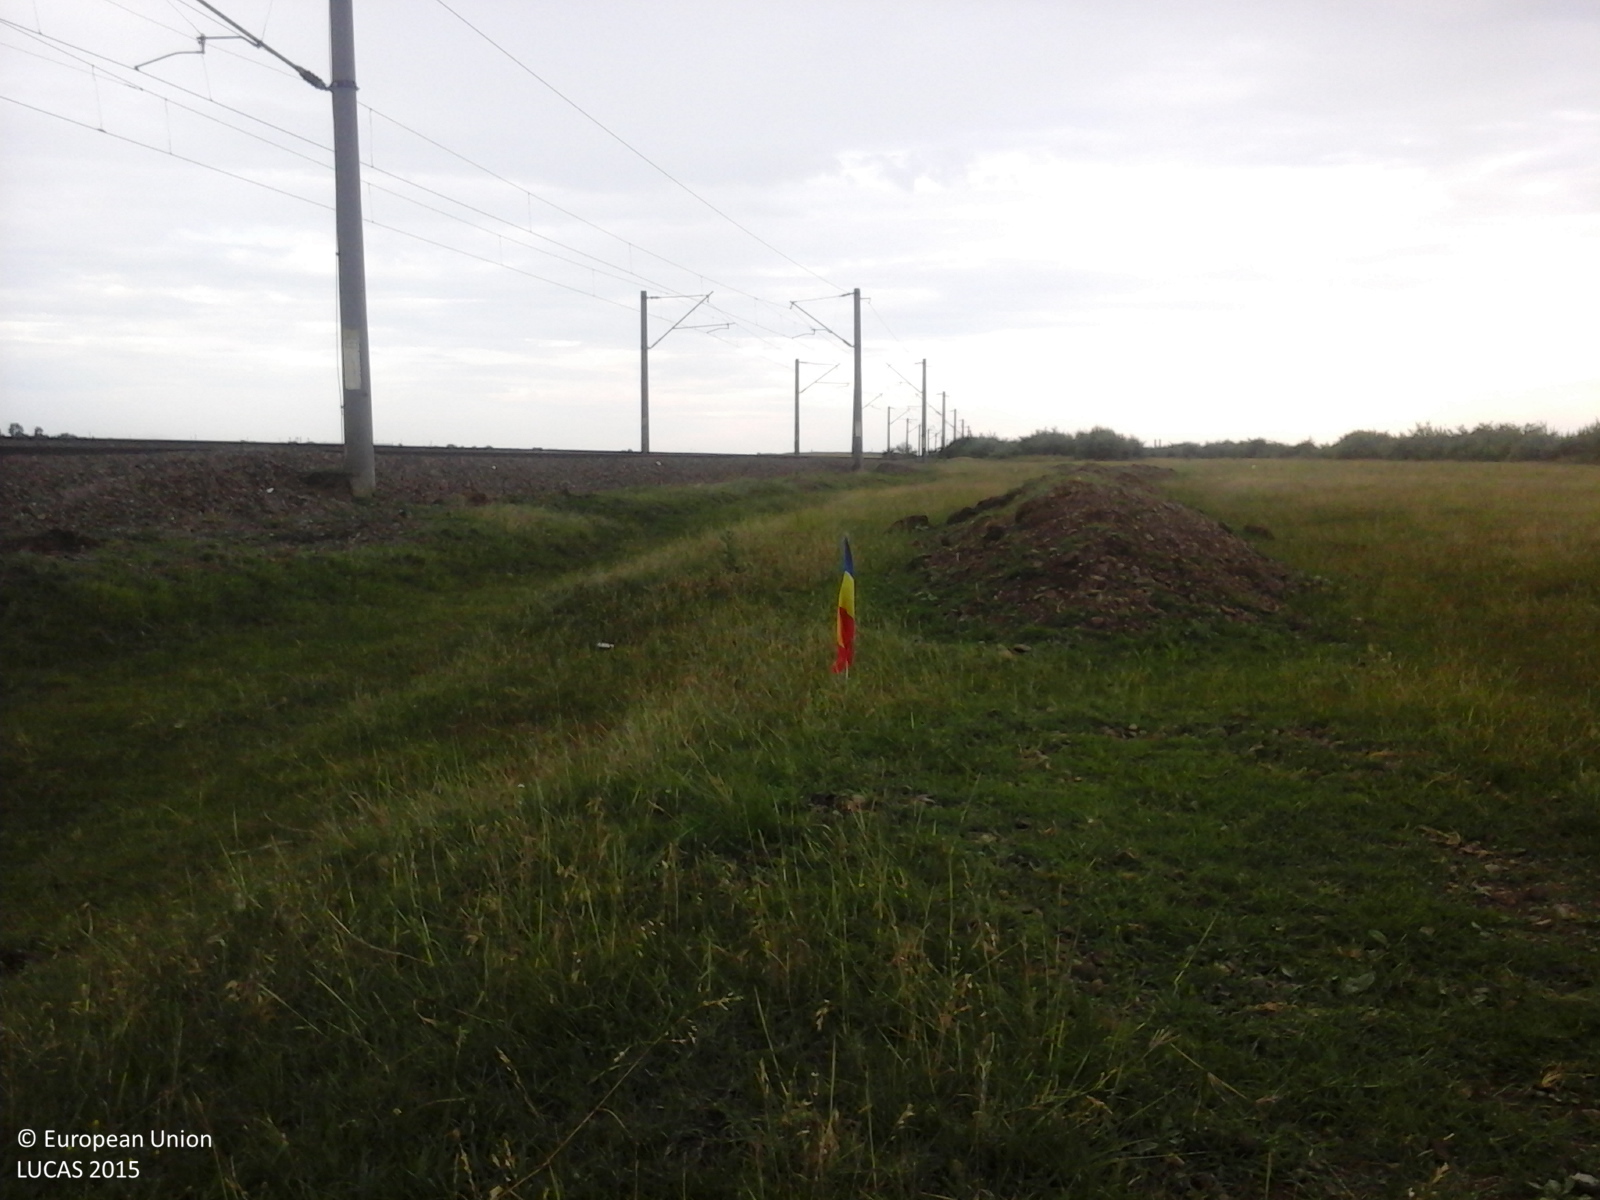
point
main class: Grassland
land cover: Grassland without tree/shrub cover
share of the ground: > 75 %
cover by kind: herbaceous plants 100 %
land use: Agriculture (excluding fallow land and kitchen gardens)
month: July
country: RO
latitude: 44.1094
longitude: 24.9056
